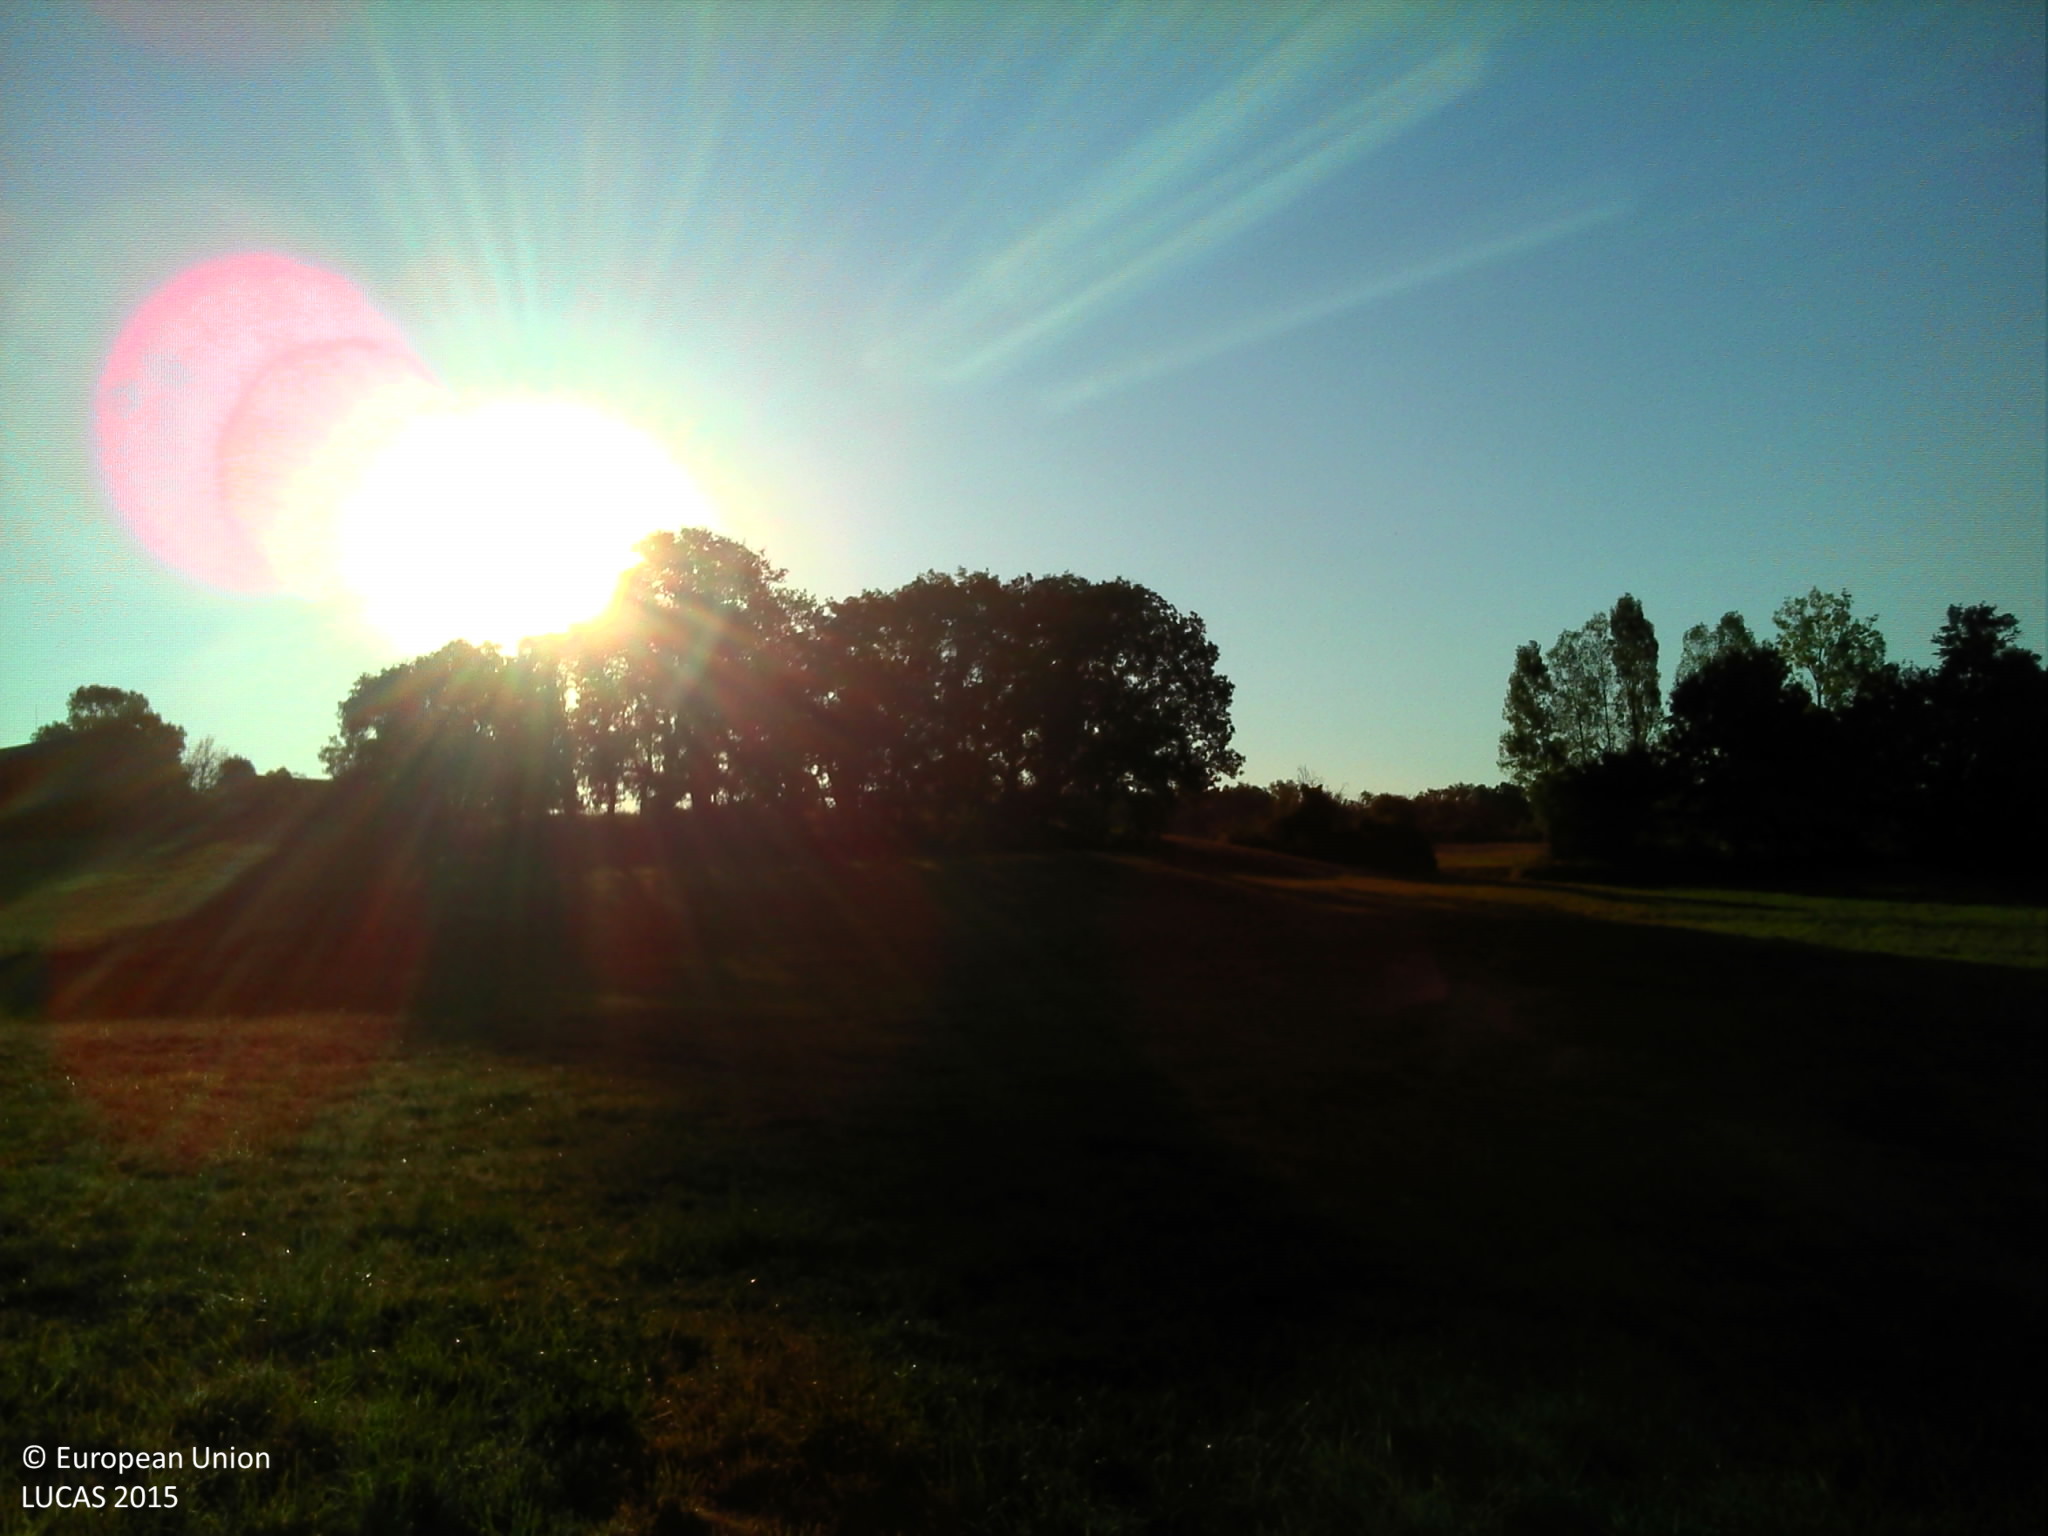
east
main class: Grassland
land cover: Grassland without tree/shrub cover
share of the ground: > 75 %
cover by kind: herbaceous plants 90 %, shrubs 5 %, lichens and mosses 5 %
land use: Agriculture (excluding fallow land and kitchen gardens)
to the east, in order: Grassland without tree/shrub cover; Abandoned hedges; Grassland without tree/shrub cover; Fences; Managed hedges; Grass margins; Paved roads, cycling and walking lanes; Grass margins; Electric lines; Fences; Grassland without tree/shrub cover; Other bare soil
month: August
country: FR
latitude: 44.8253
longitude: 0.7468
